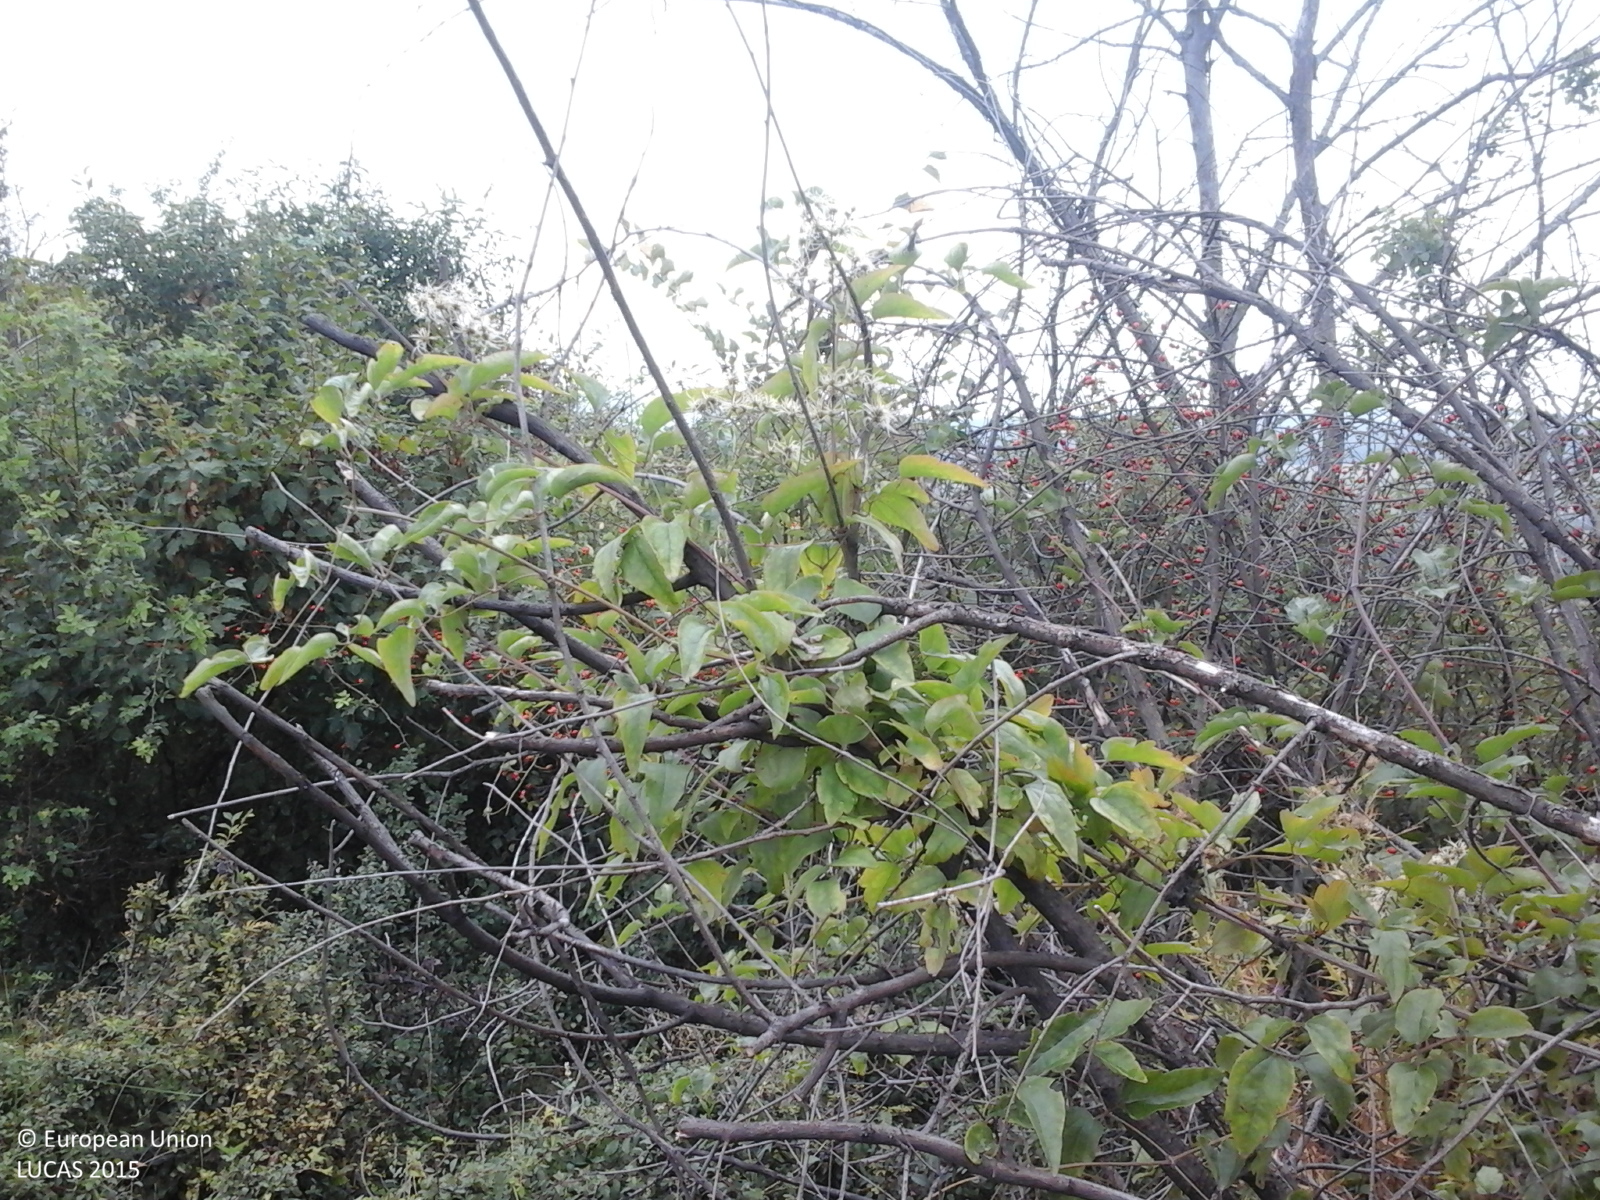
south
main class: Grassland
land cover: Grassland without tree/shrub cover
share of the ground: > 75 %
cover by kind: herbaceous plants 100 %
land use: Agriculture (excluding fallow land and kitchen gardens)
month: September
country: RO
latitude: 47.2671
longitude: 22.3855
